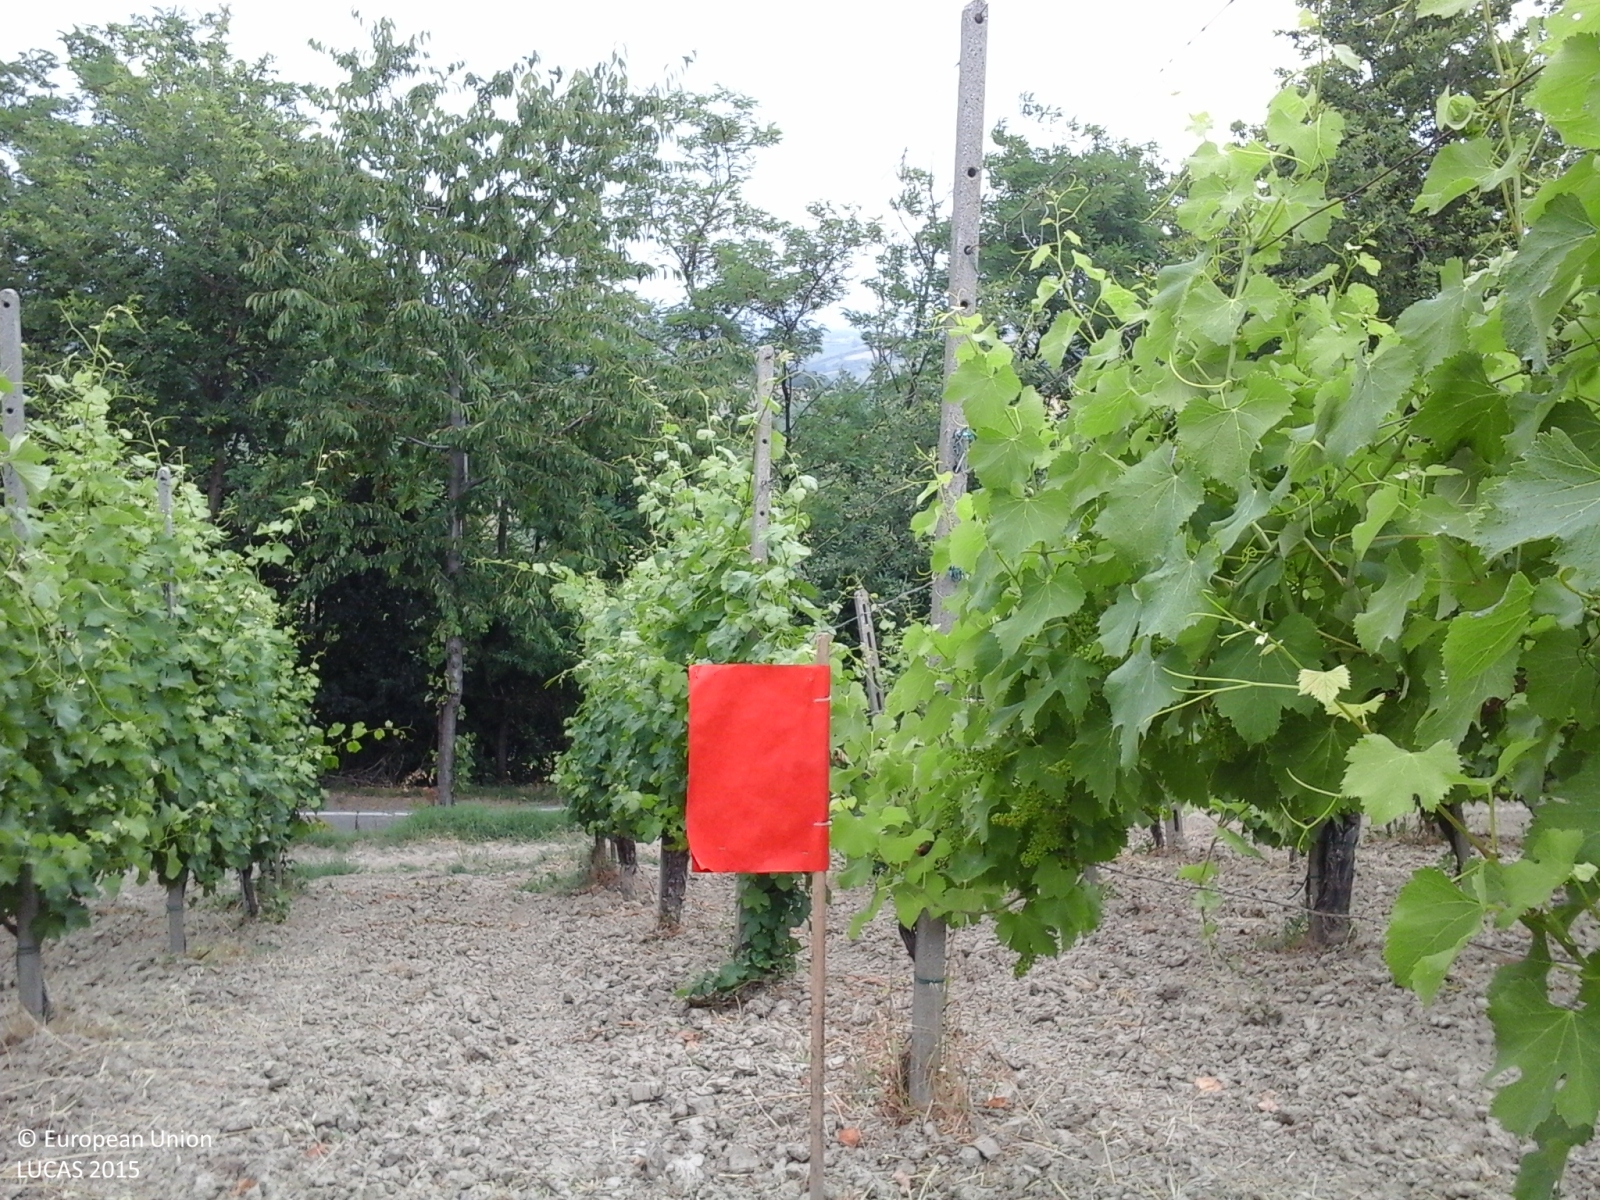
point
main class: Cropland
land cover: Vineyards
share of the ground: < 10 %
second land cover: Other bare soil
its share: > 75 %
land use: Agriculture (excluding fallow land and kitchen gardens)
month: June
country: IT
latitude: 44.8374
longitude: 9.8864
